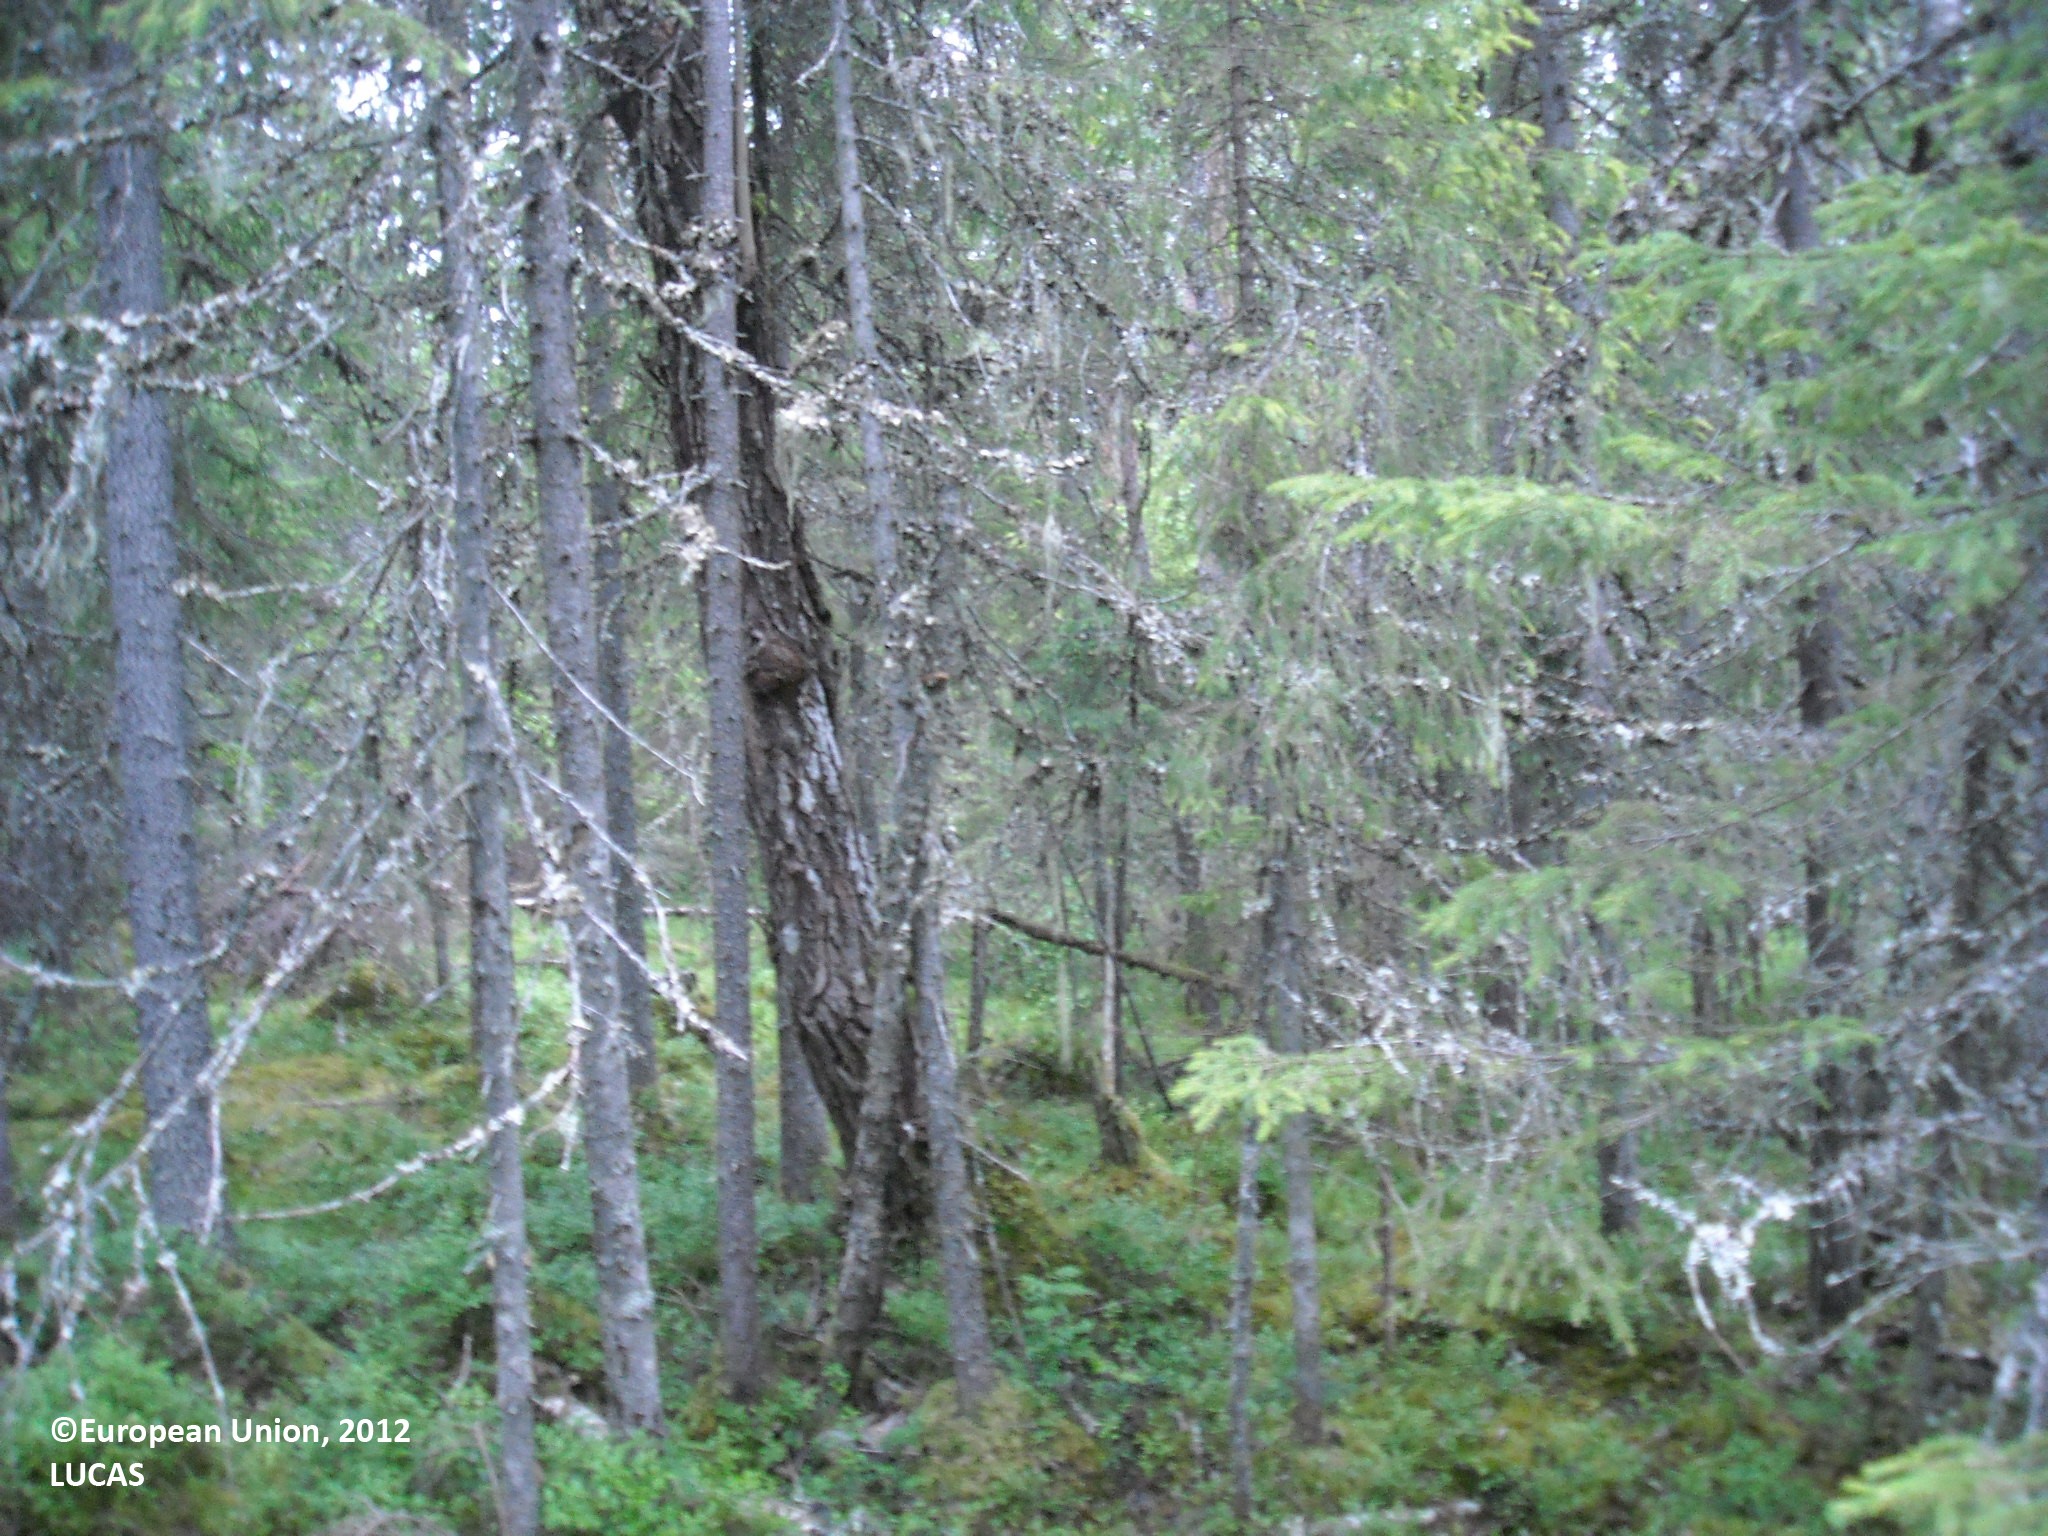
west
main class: Woodland
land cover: Other coniferous woodland
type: boreal forest
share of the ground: > 75 %
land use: Semi-natural and natural areas not in use
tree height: > 5 m
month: July
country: FI
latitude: 65.0223
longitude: 26.7326
